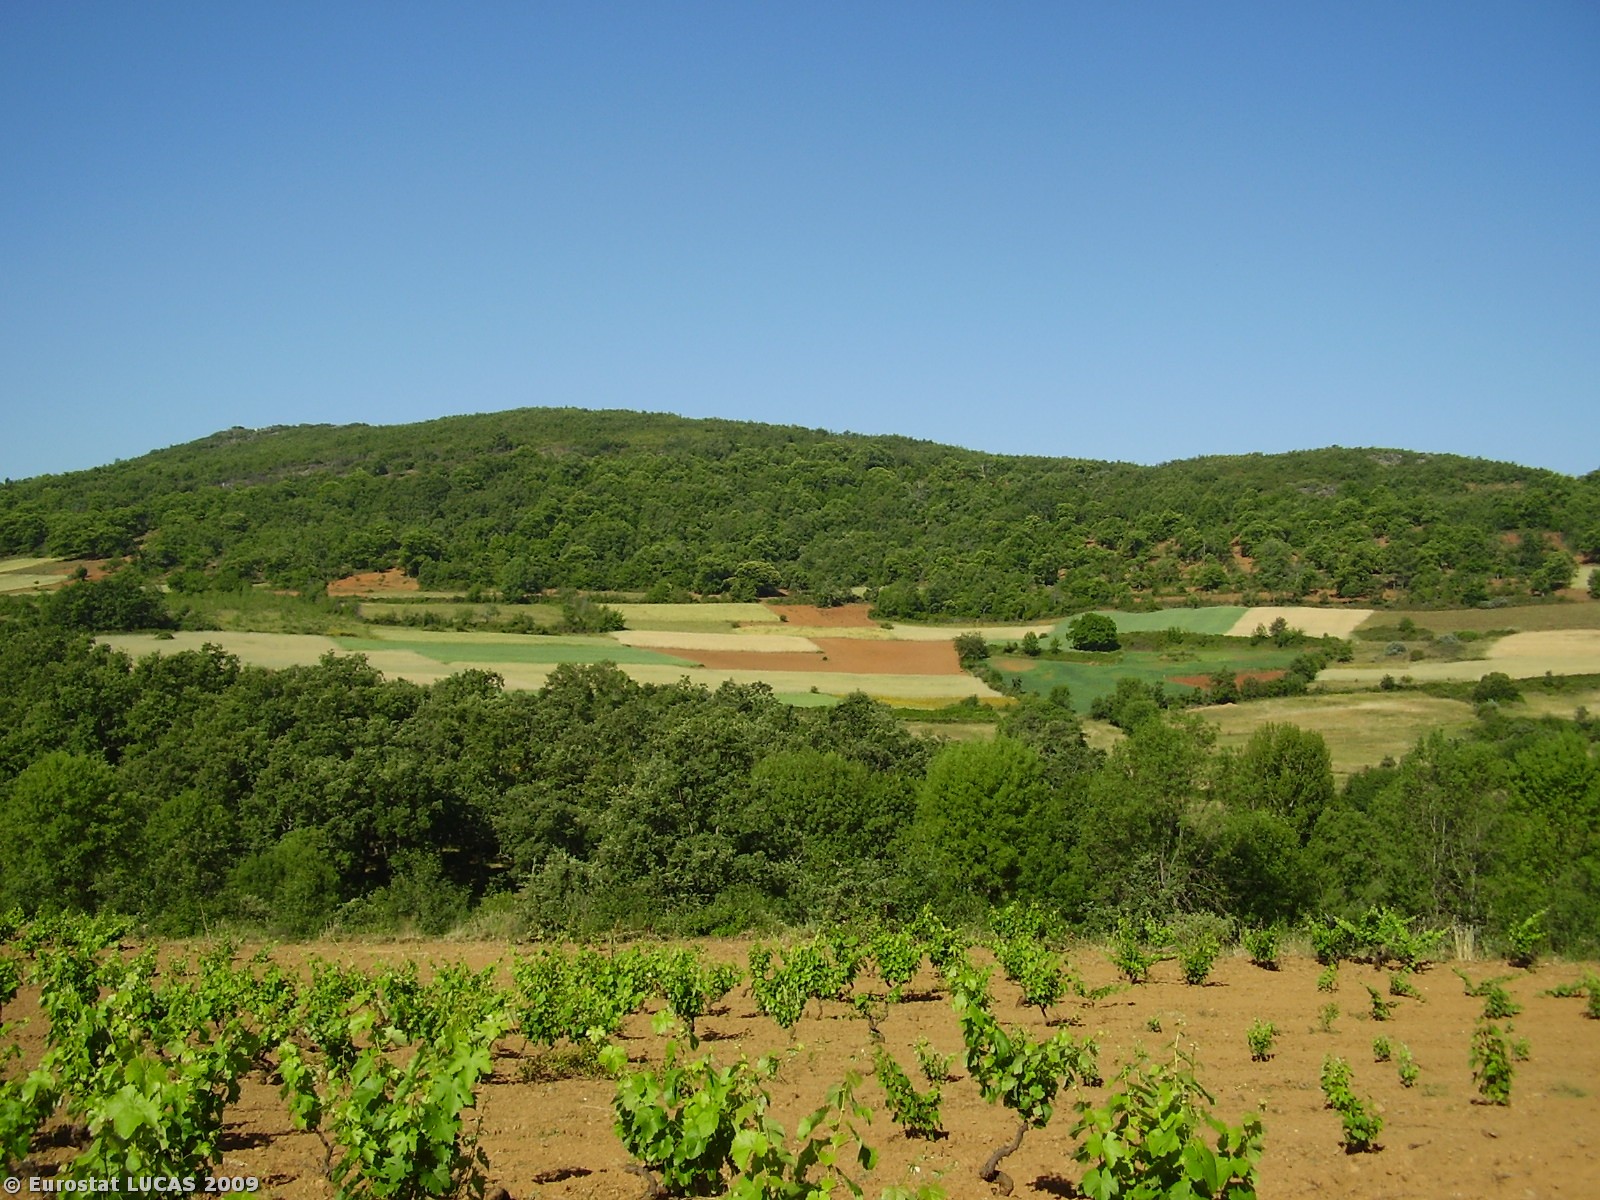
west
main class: Cropland
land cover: Vineyards
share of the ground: 25 - 50 %
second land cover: Bare land
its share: 10 - 25 %
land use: Agriculture (excluding fallow land and kitchen gardens)
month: June
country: PT
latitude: 41.8015
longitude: -6.9555
